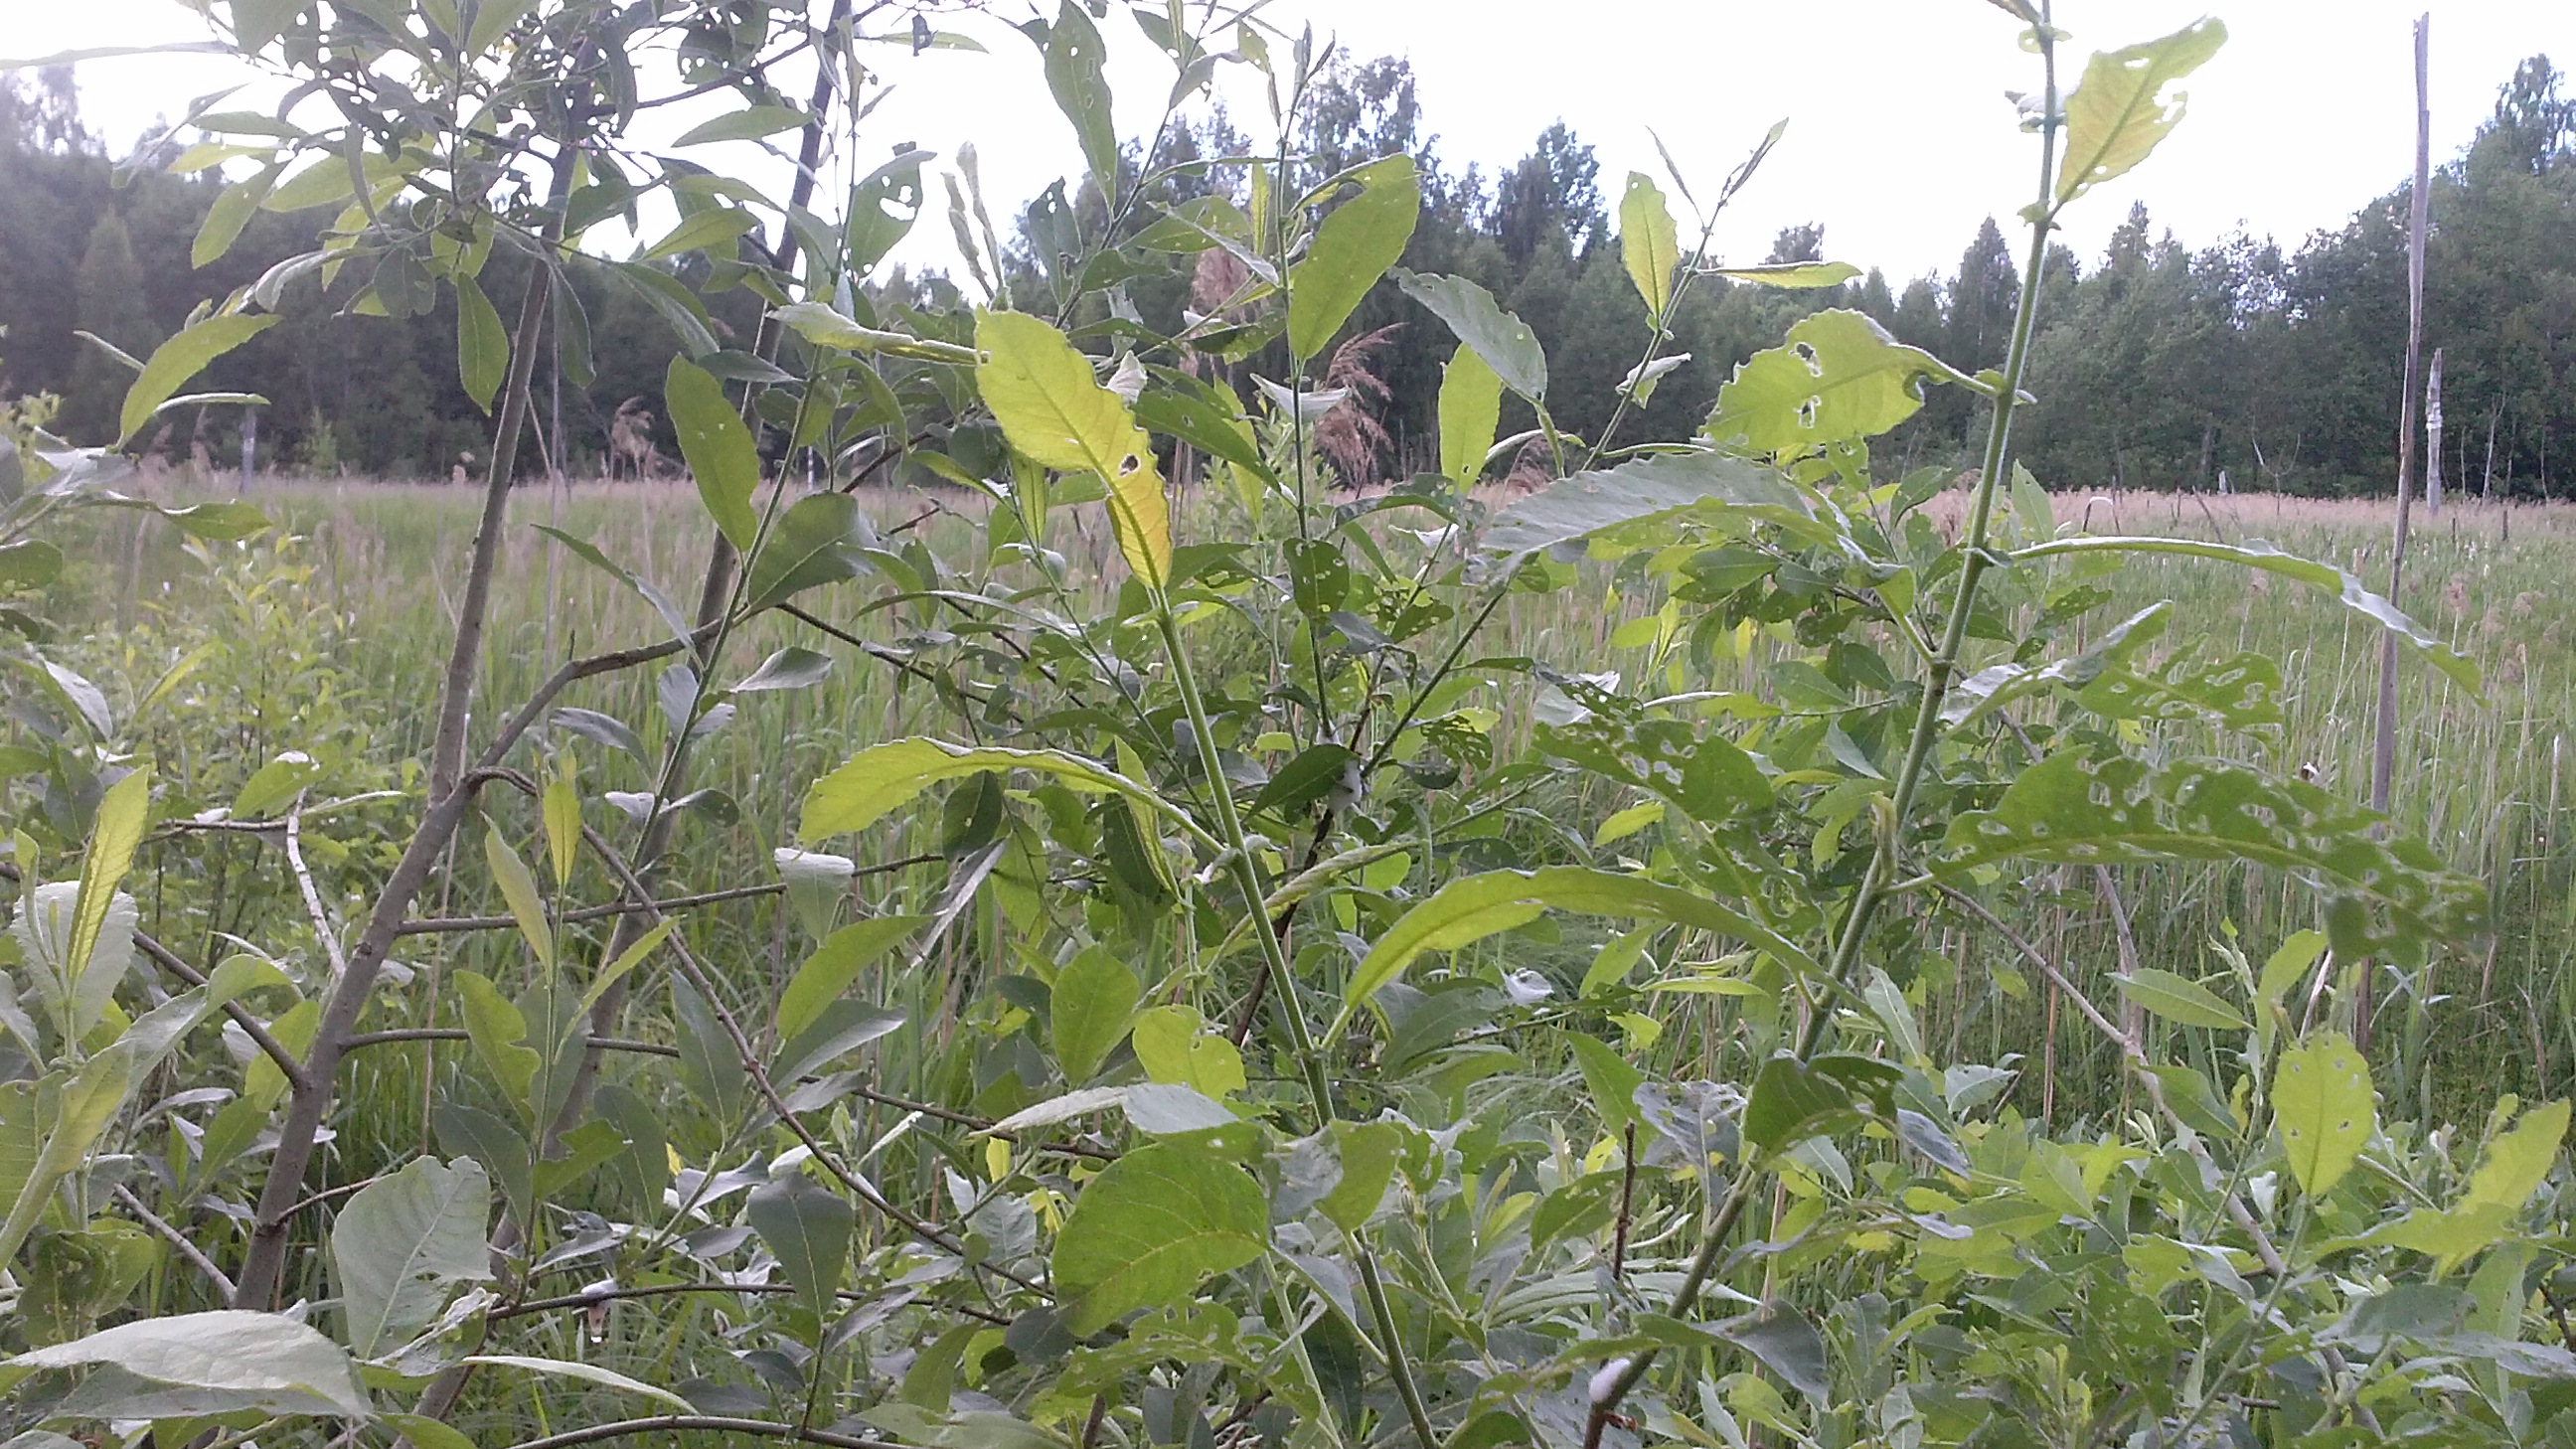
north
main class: Shrubland
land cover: Shrubland without tree cover
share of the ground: > 75 %
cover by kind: shrubs 80 %, herbaceous plants 20 %
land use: Semi-natural and natural areas not in use
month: June
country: LV
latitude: 56.4138
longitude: 27.6075
